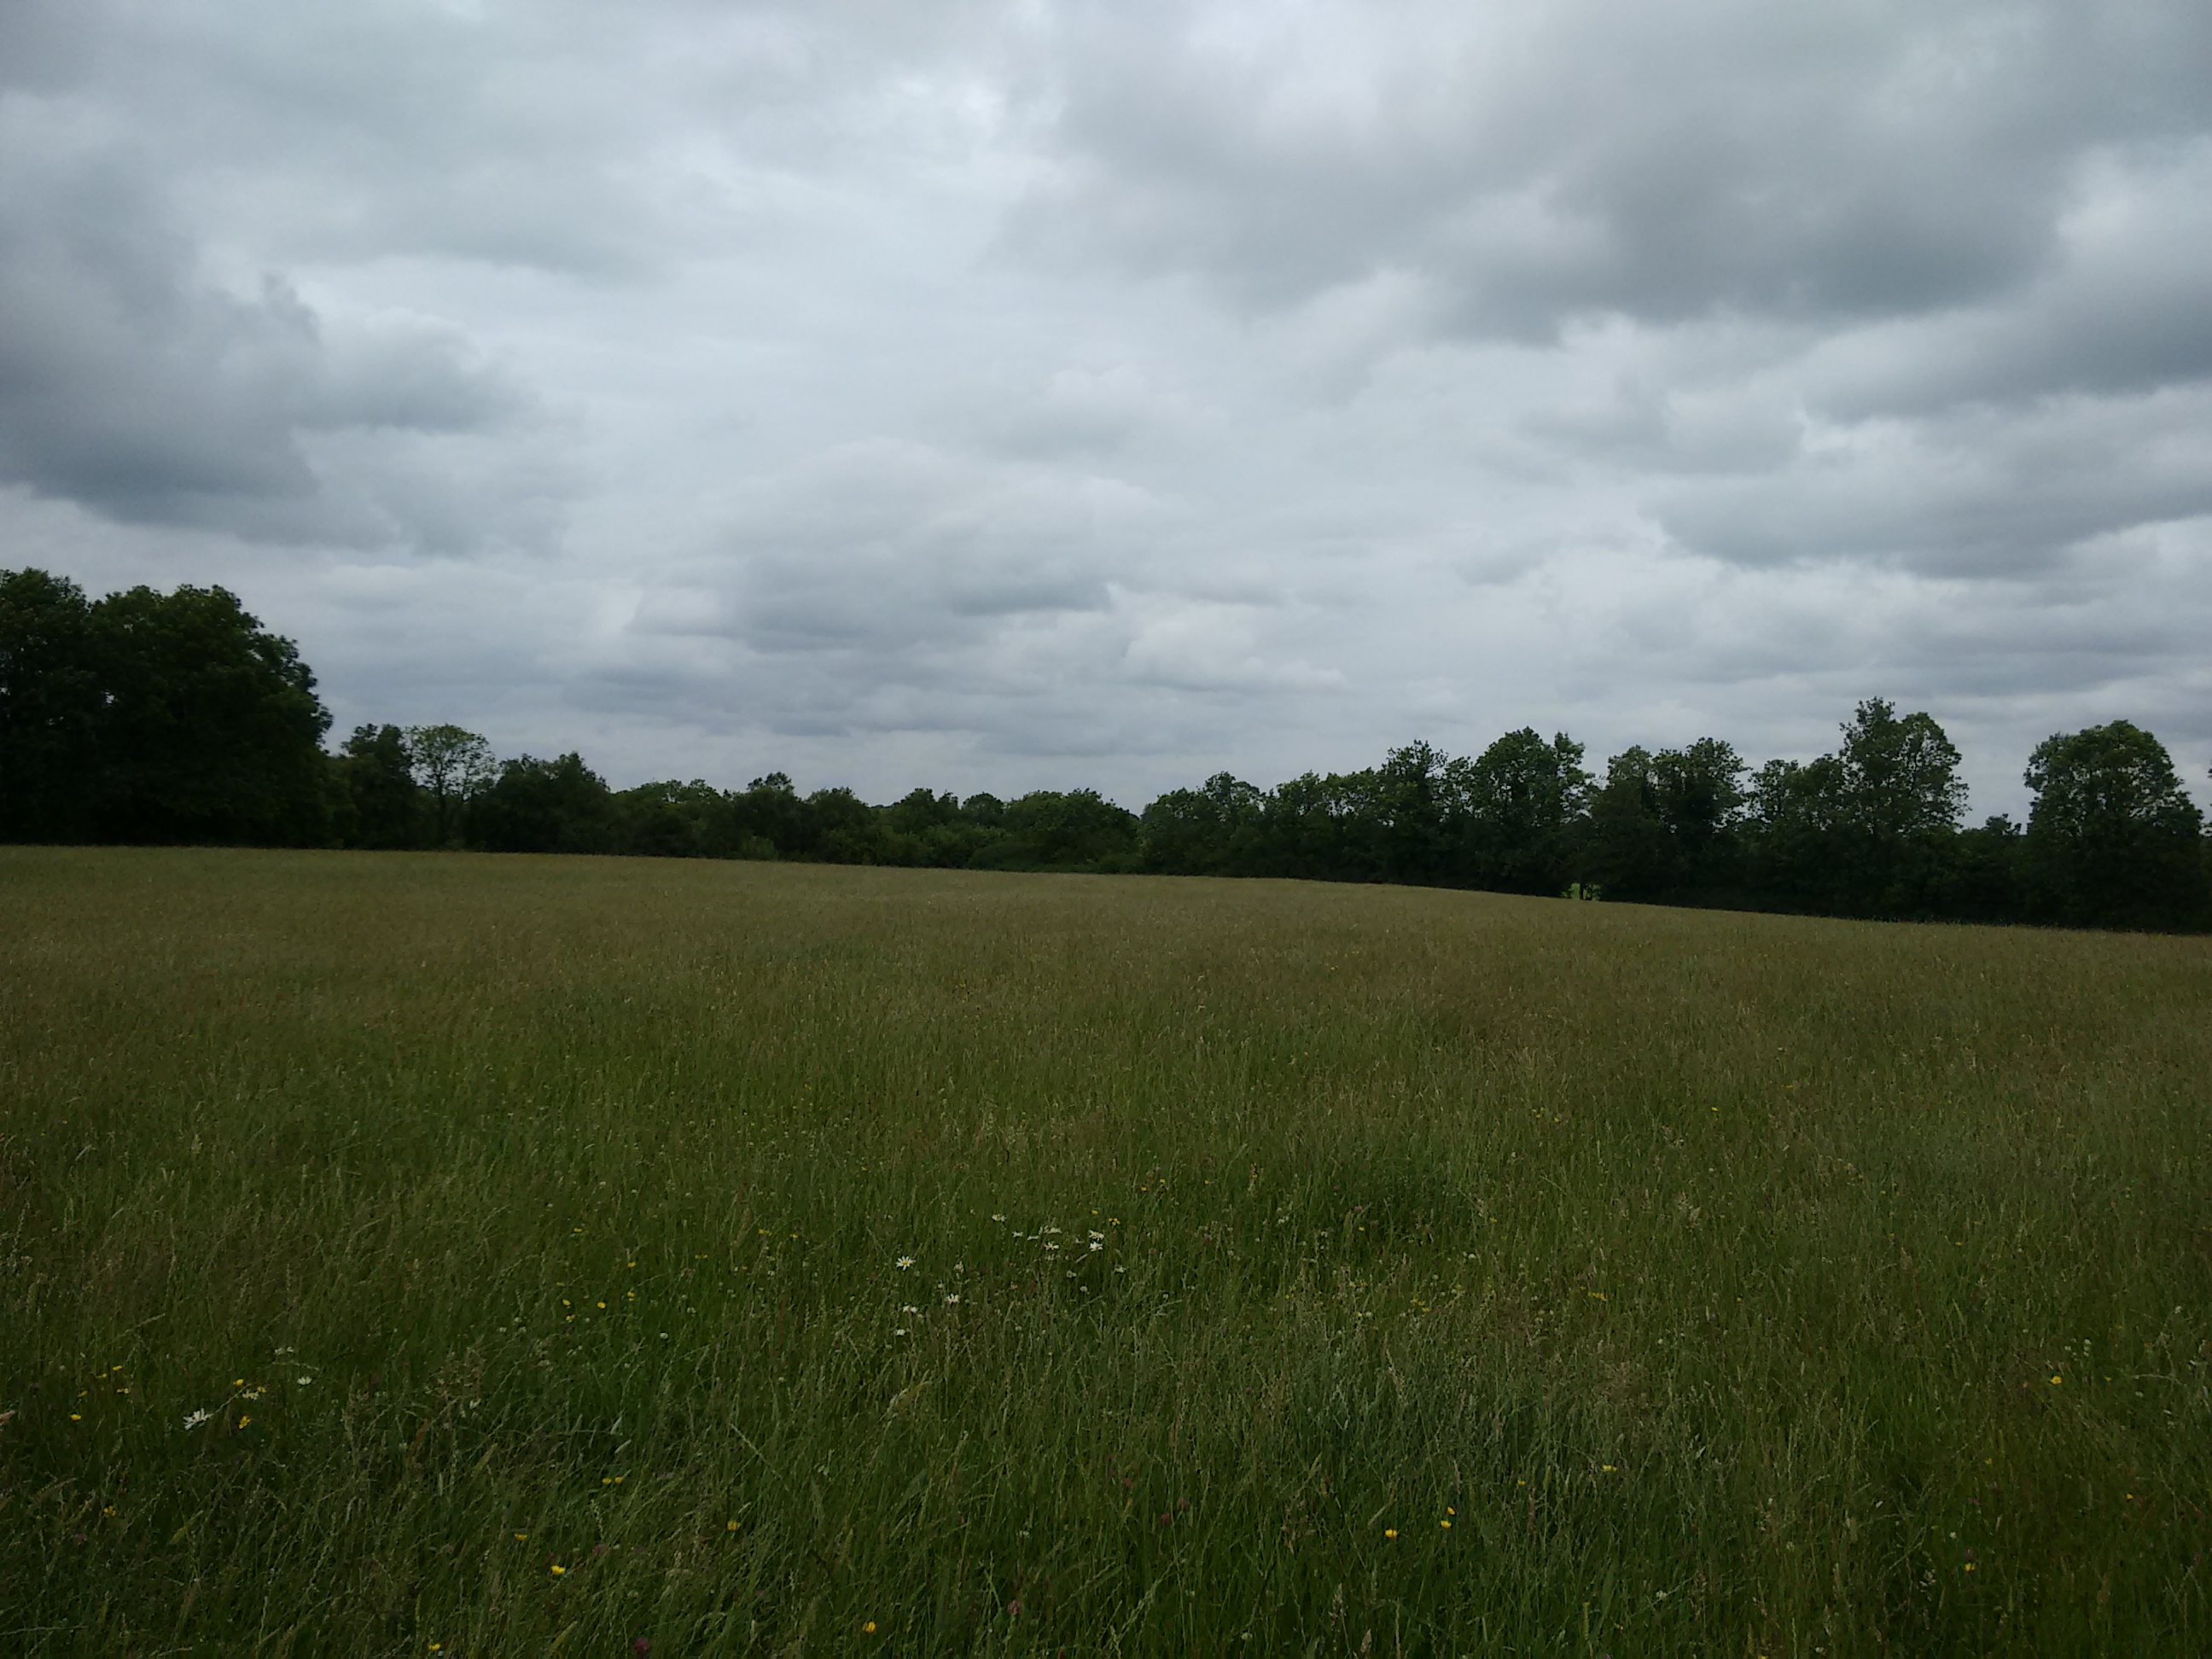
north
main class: Grassland
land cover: Spontaneously vegetated surfaces
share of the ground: > 75 %
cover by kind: herbaceous plants 95 %, shrubs 5 %
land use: Fallow land
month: June
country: IE
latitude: 53.4331
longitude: -7.6690
